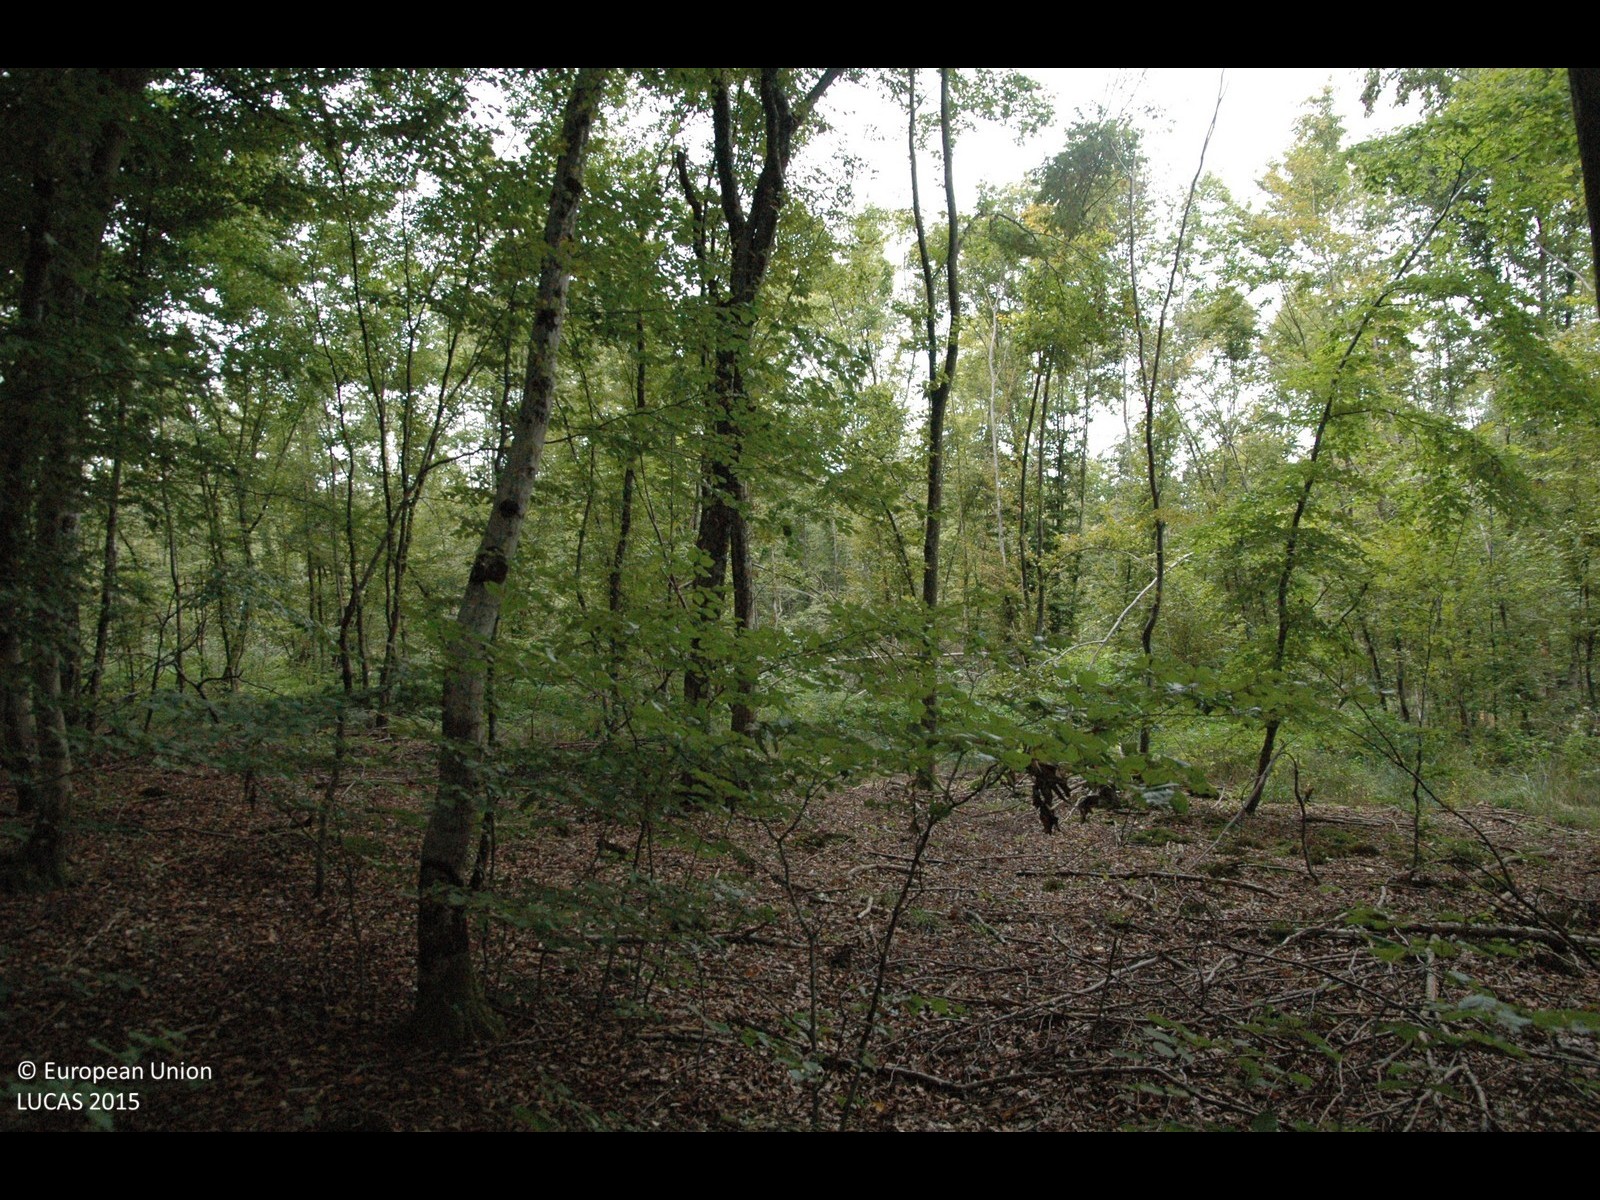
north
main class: Woodland
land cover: Broadleaved woodland
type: beech forest
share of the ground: > 75 %
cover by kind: broadleaved forest trees 100 %
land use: Forestry
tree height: > 5 m
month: October
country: HR
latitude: 45.5609
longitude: 16.1342
